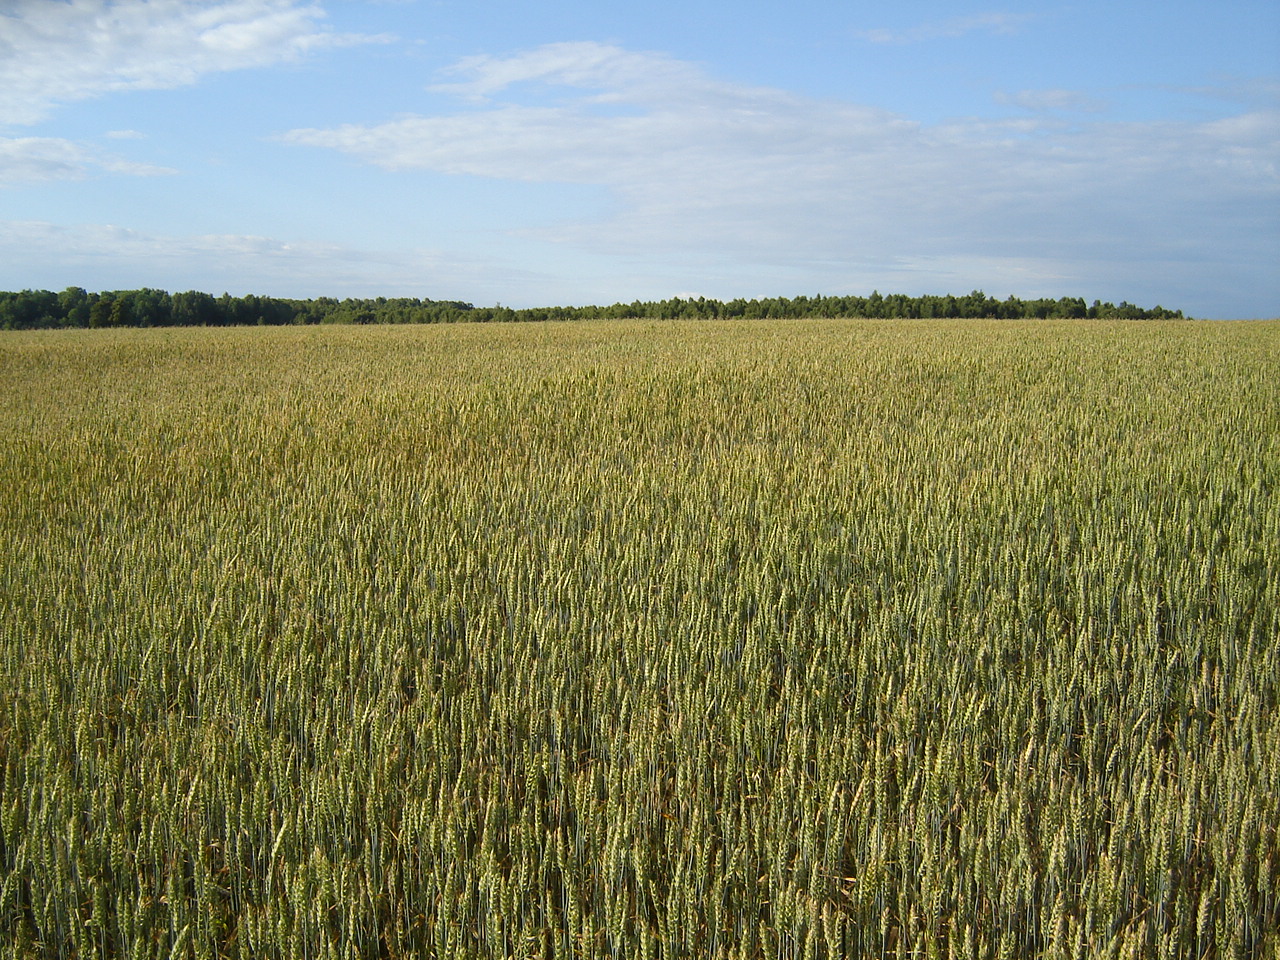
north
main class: Cropland
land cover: Common wheat
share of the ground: > 75 %
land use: Agriculture (excluding fallow land and kitchen gardens)
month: July
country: LT
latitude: 55.3323
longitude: 24.7186
